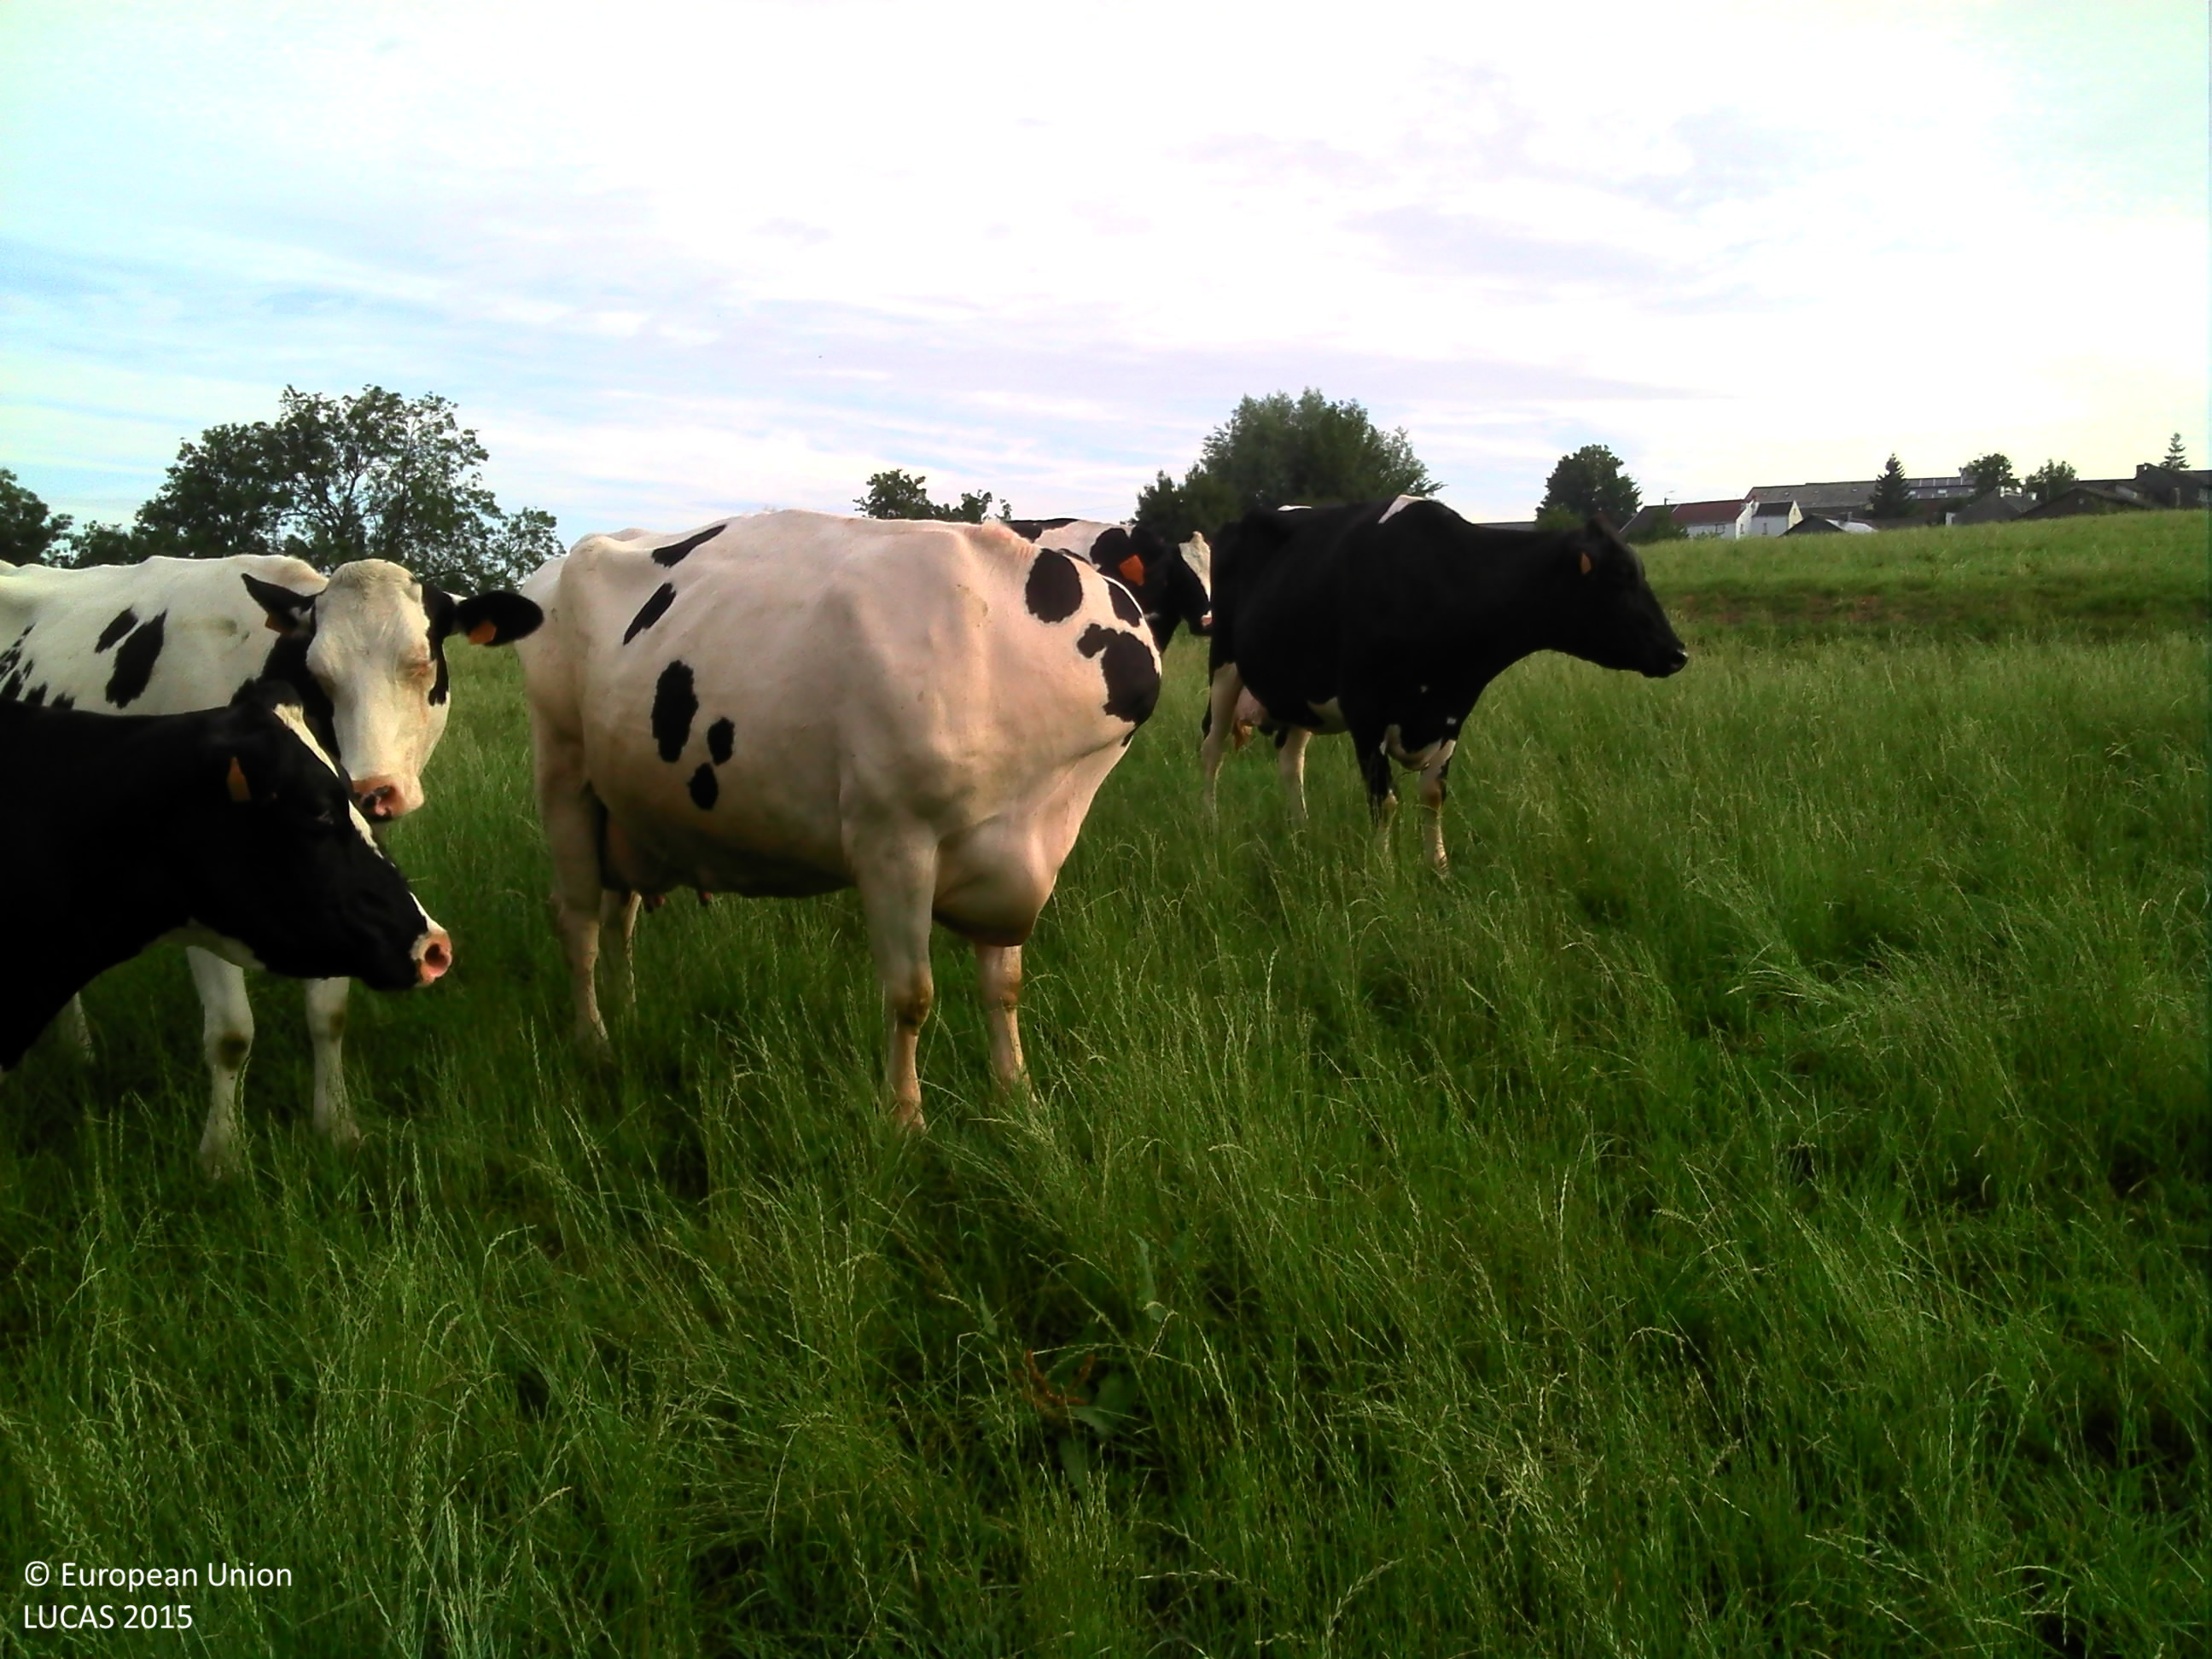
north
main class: Grassland
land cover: Grassland without tree/shrub cover
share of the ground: > 75 %
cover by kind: herbaceous plants 100 %
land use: Agriculture (excluding fallow land and kitchen gardens)
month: July
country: BE
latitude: 50.6808
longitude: 5.7387
